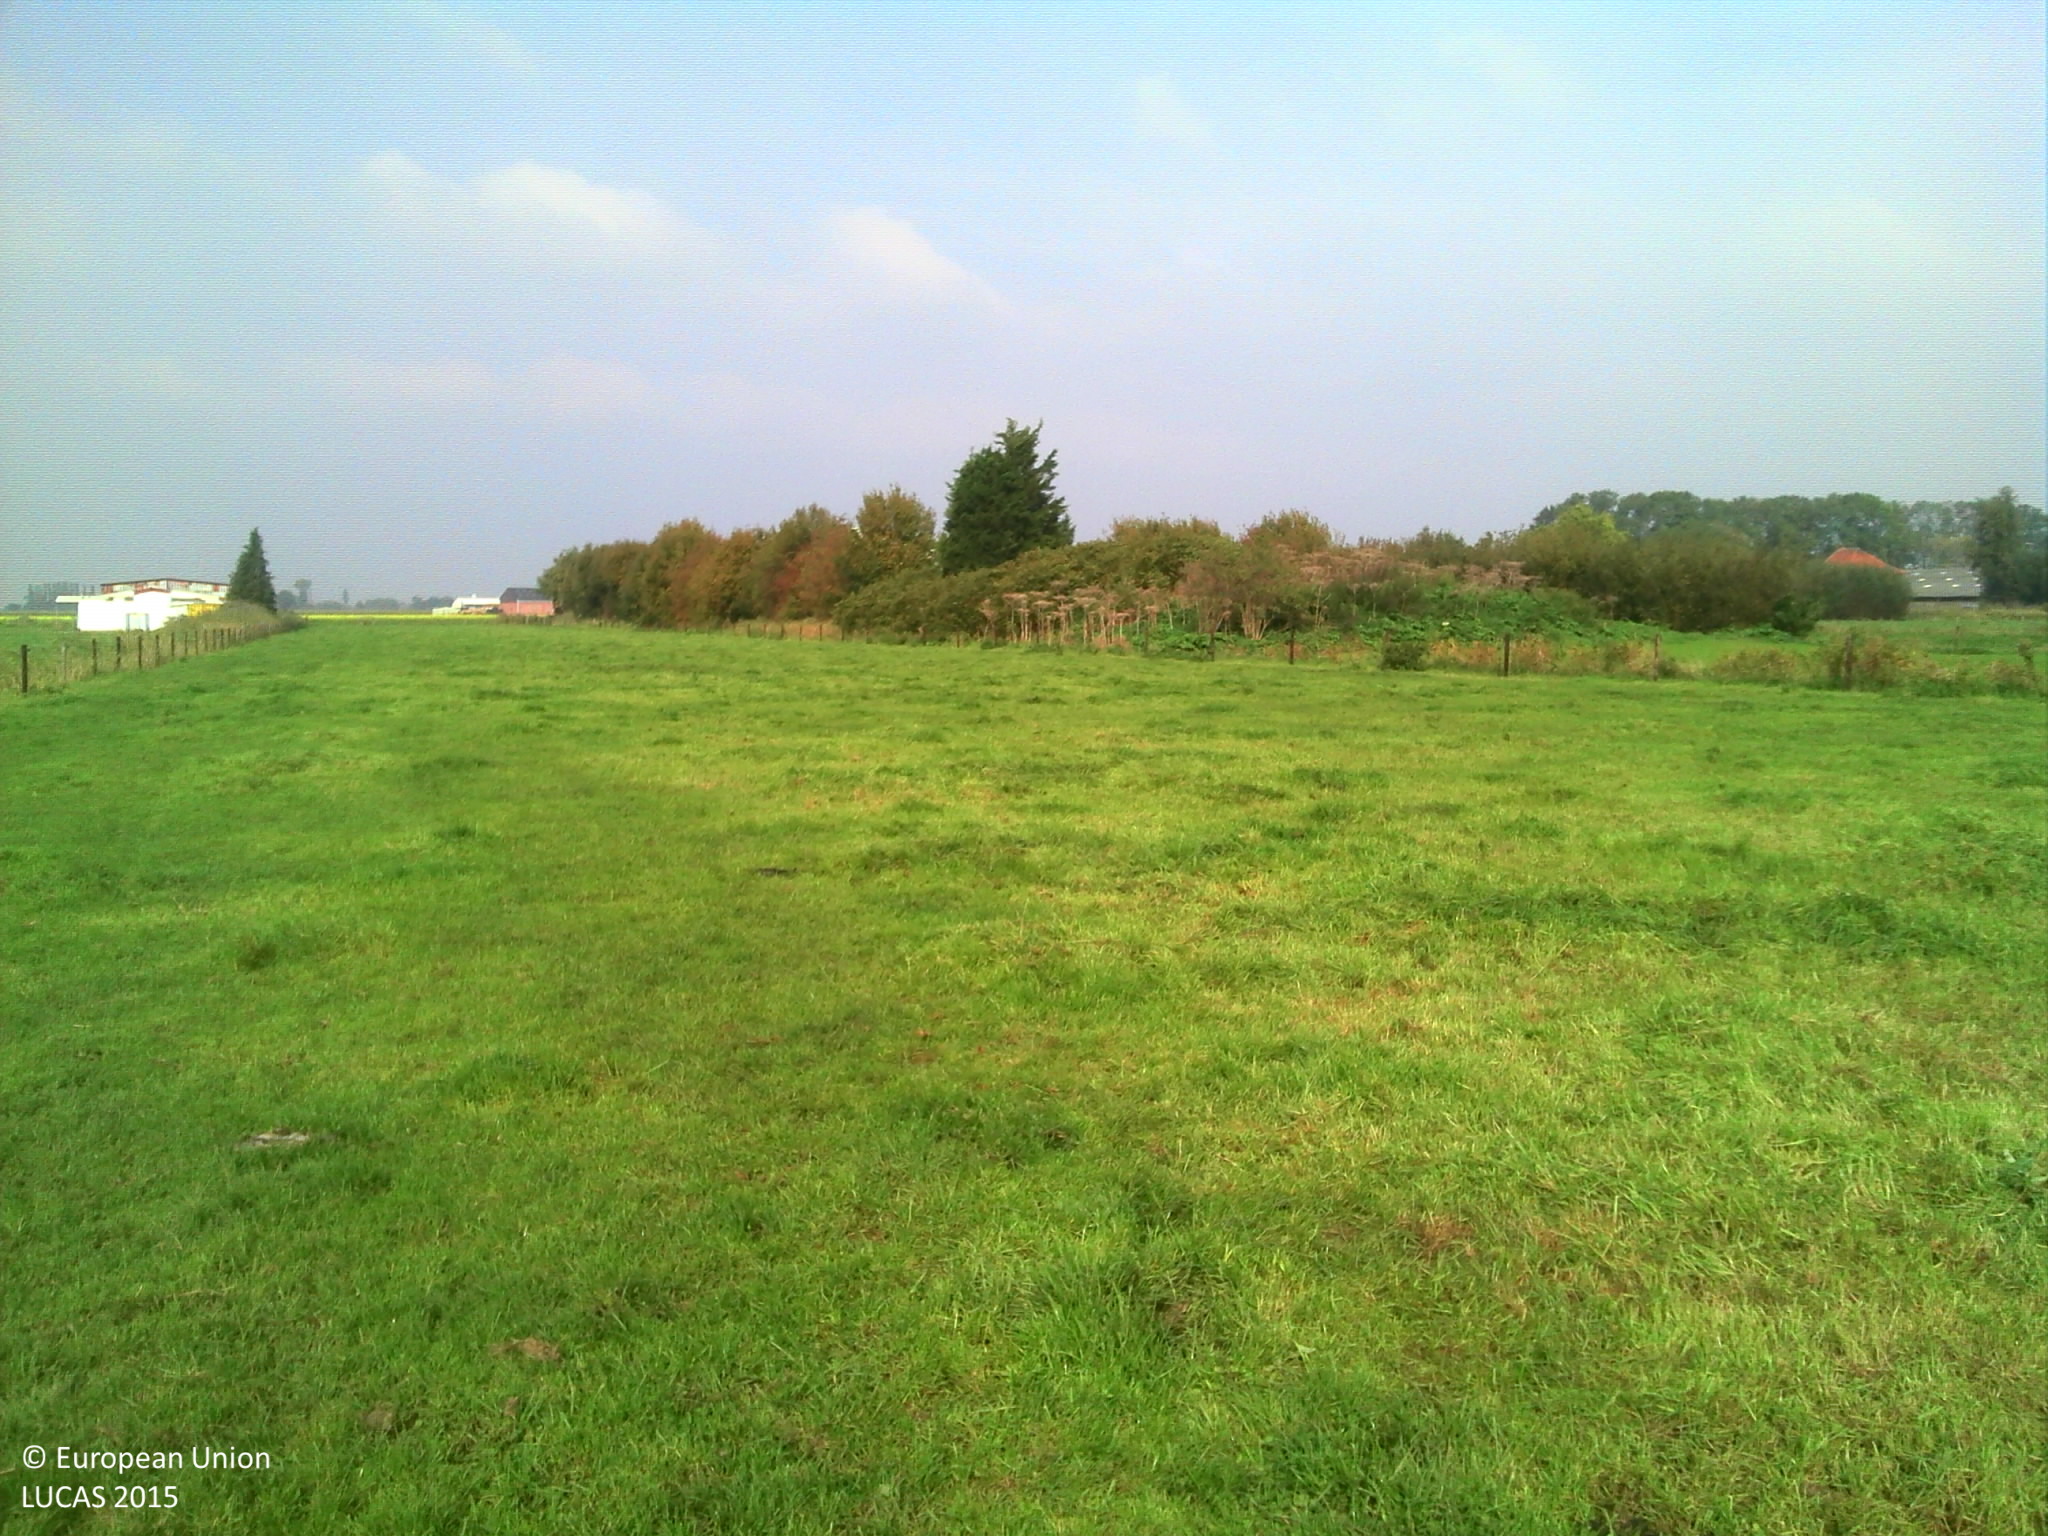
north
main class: Grassland
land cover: Grassland without tree/shrub cover
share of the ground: > 75 %
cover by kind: herbaceous plants 100 %
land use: Agriculture (excluding fallow land and kitchen gardens)
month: October
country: BE
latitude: 51.3077
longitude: 4.3865
